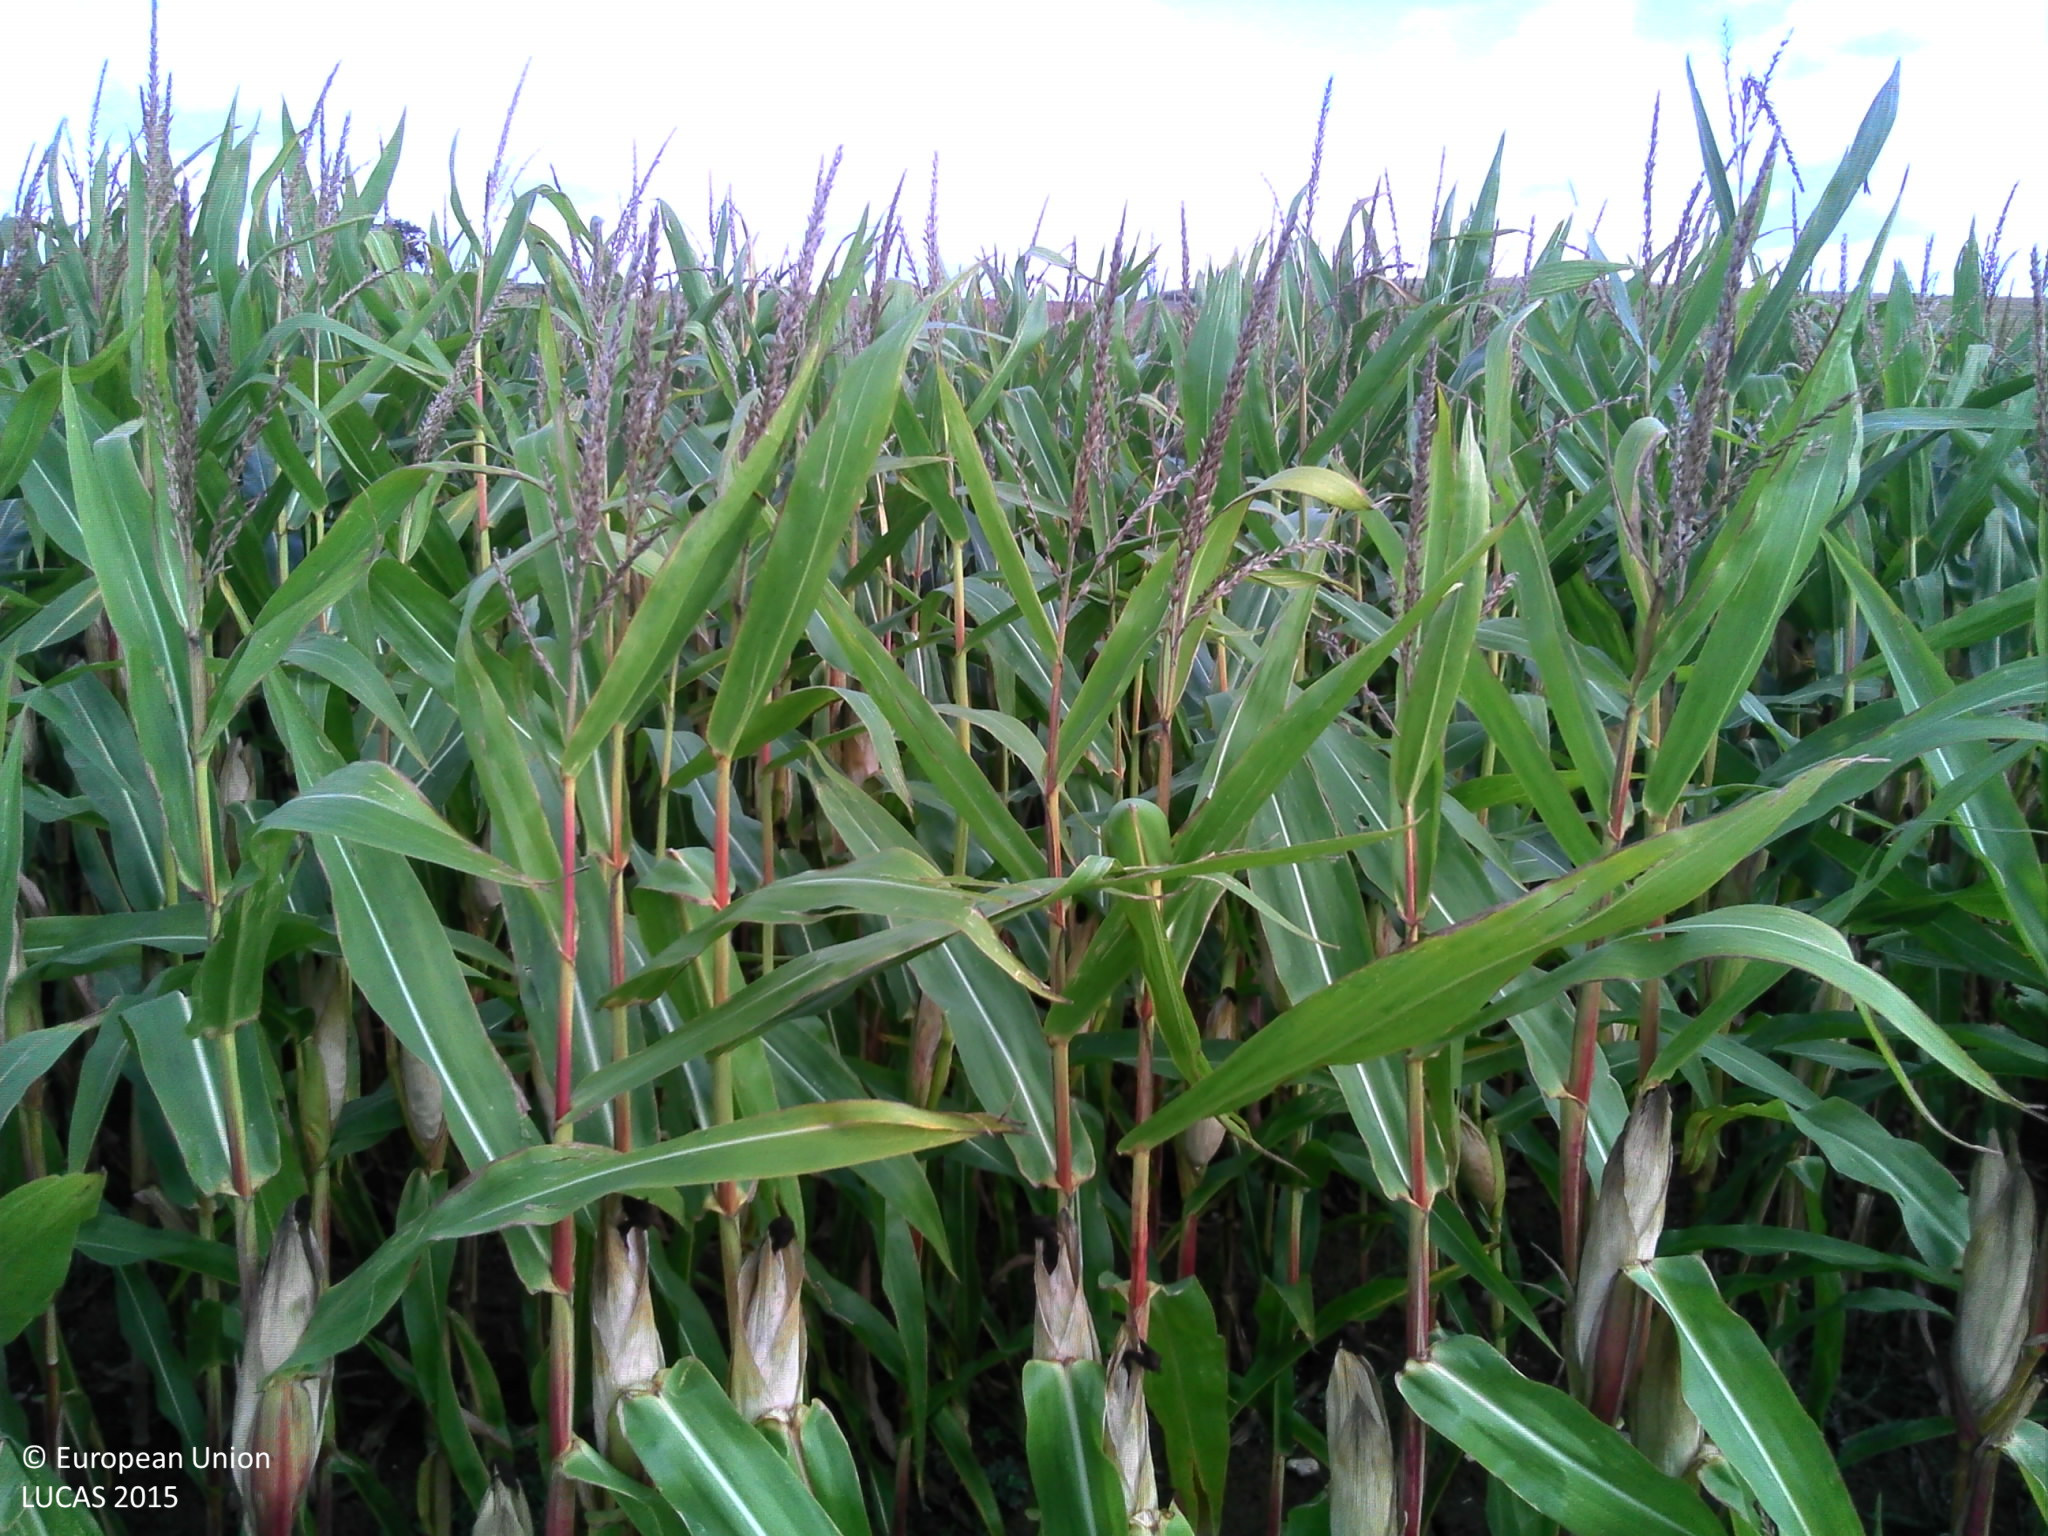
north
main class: Cropland
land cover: Maize
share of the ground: > 75 %
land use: Agriculture (excluding fallow land and kitchen gardens)
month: August
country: FR
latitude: 48.8110
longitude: 7.6721
